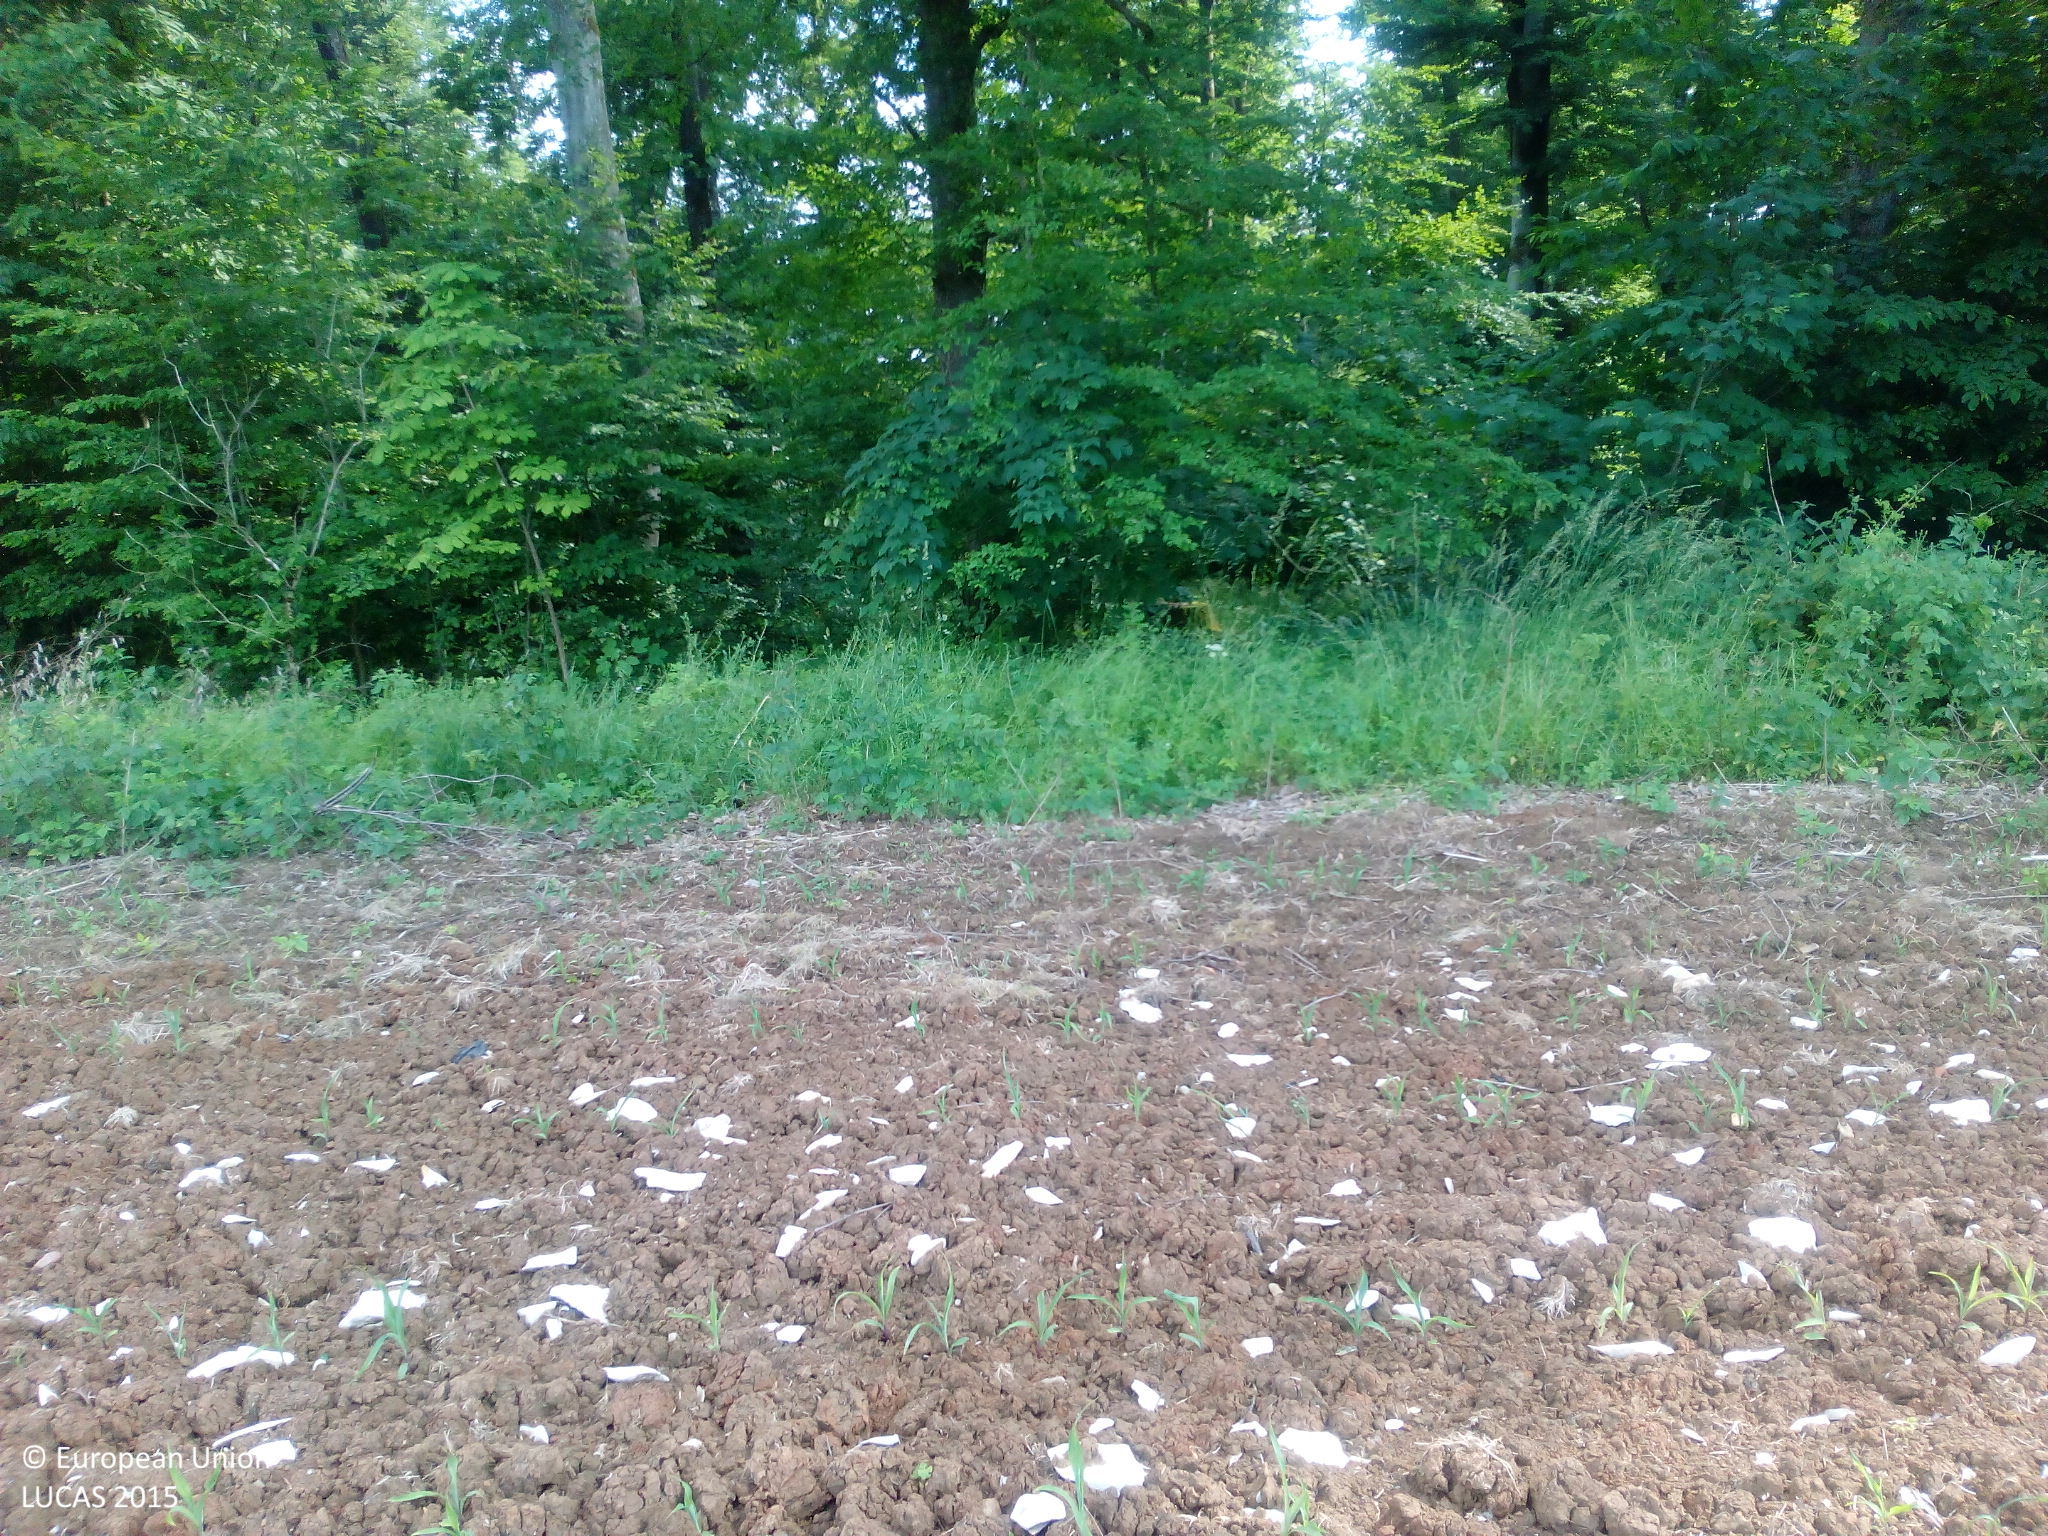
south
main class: Cropland
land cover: Maize
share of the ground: < 10 %
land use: Agriculture (excluding fallow land and kitchen gardens)
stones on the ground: < 10 %
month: June
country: DE
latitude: 48.9577
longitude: 10.8873
